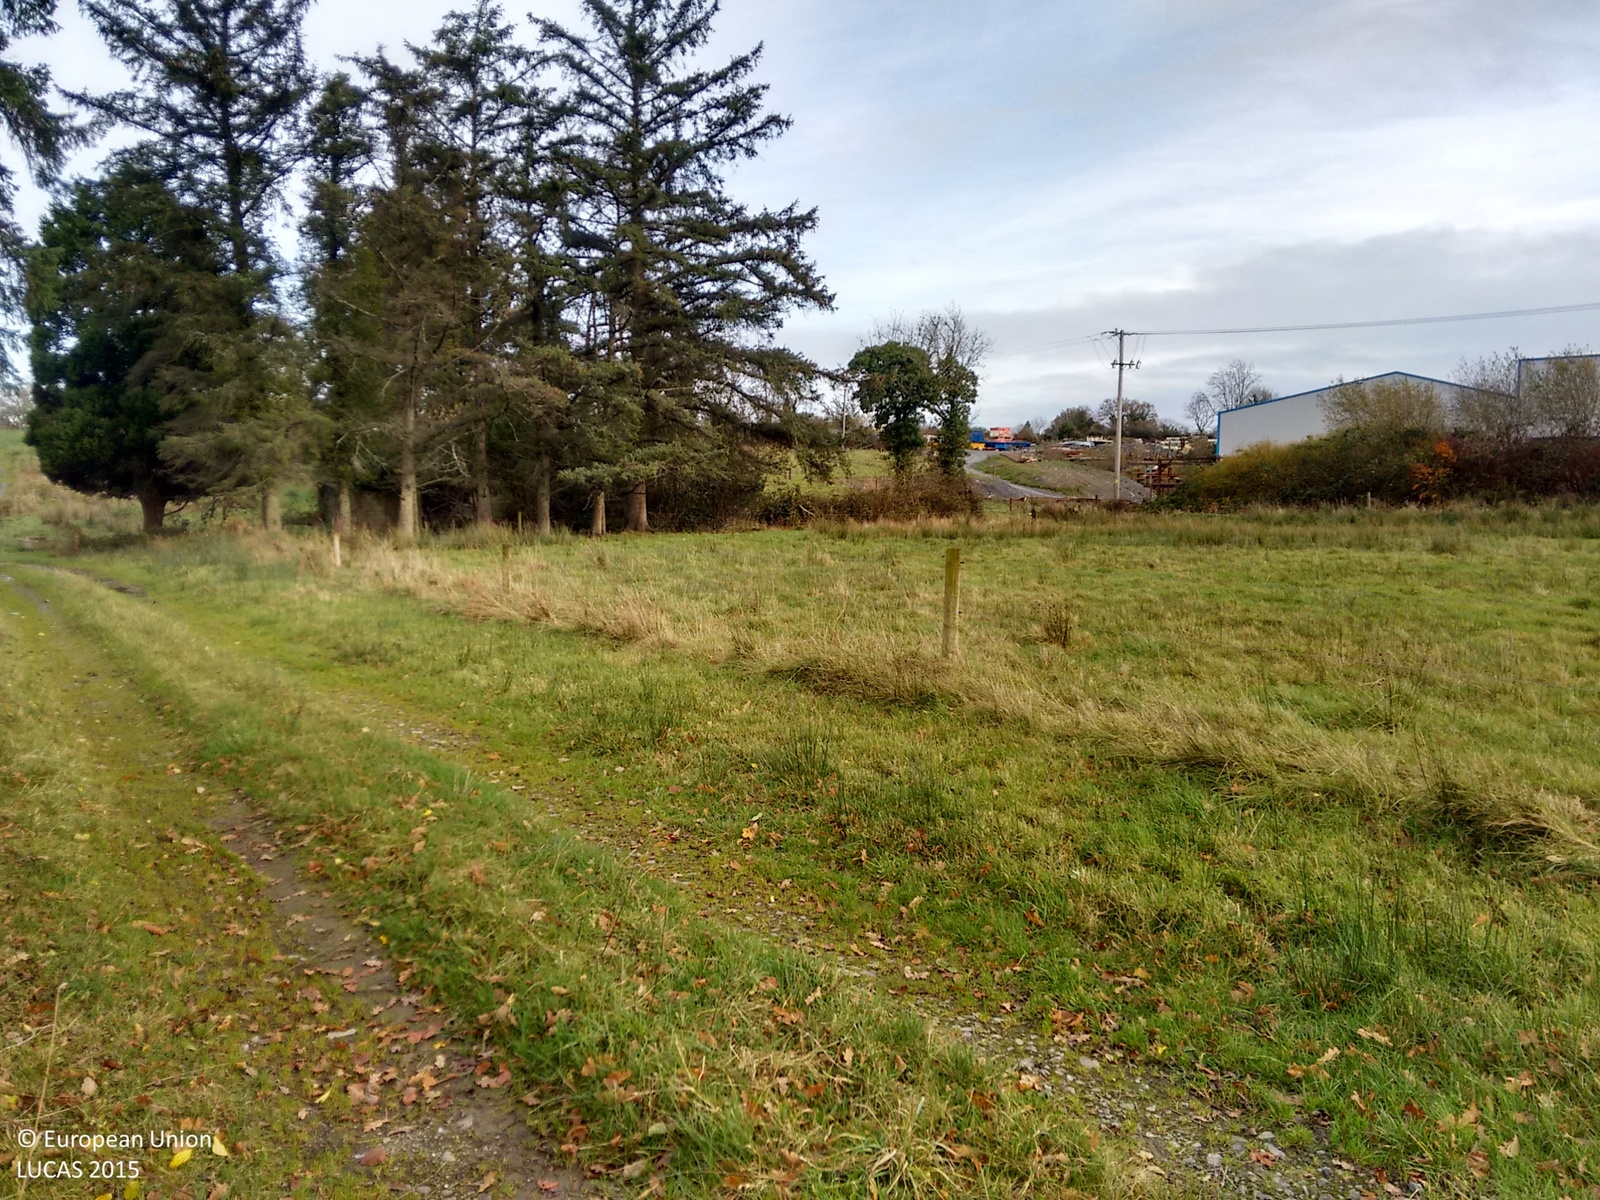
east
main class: Grassland
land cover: Grassland without tree/shrub cover
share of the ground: > 75 %
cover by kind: herbaceous plants 100 %
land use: Agriculture (excluding fallow land and kitchen gardens)
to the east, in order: Grassland without tree/shrub cover; Ditches and canals; Abandoned hedges; Shruby margins; Grass margins; Tracks; Electric lines; Tracks; Grass margins; Fences; Grassland without tree/shrub cover; Fences; Ditches and canals; Abandoned hedges; Shruby margins; Grass margins; Tracks; Grass margins; Fences; Grassland without tree/shrub cover; Electric lines; Artificial constructions in urban areas; Grassland without tree/shrub cover; Electric lines; Grassland without tree/shrub cover; Fences; Abandoned hedges; Ditches and canals; Artificial constructions in urban areas; Abandoned hedges; Ditches and canals; Fences; Grassland without tree/shrub cover
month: November
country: IE
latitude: 53.7541
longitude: -7.7436
